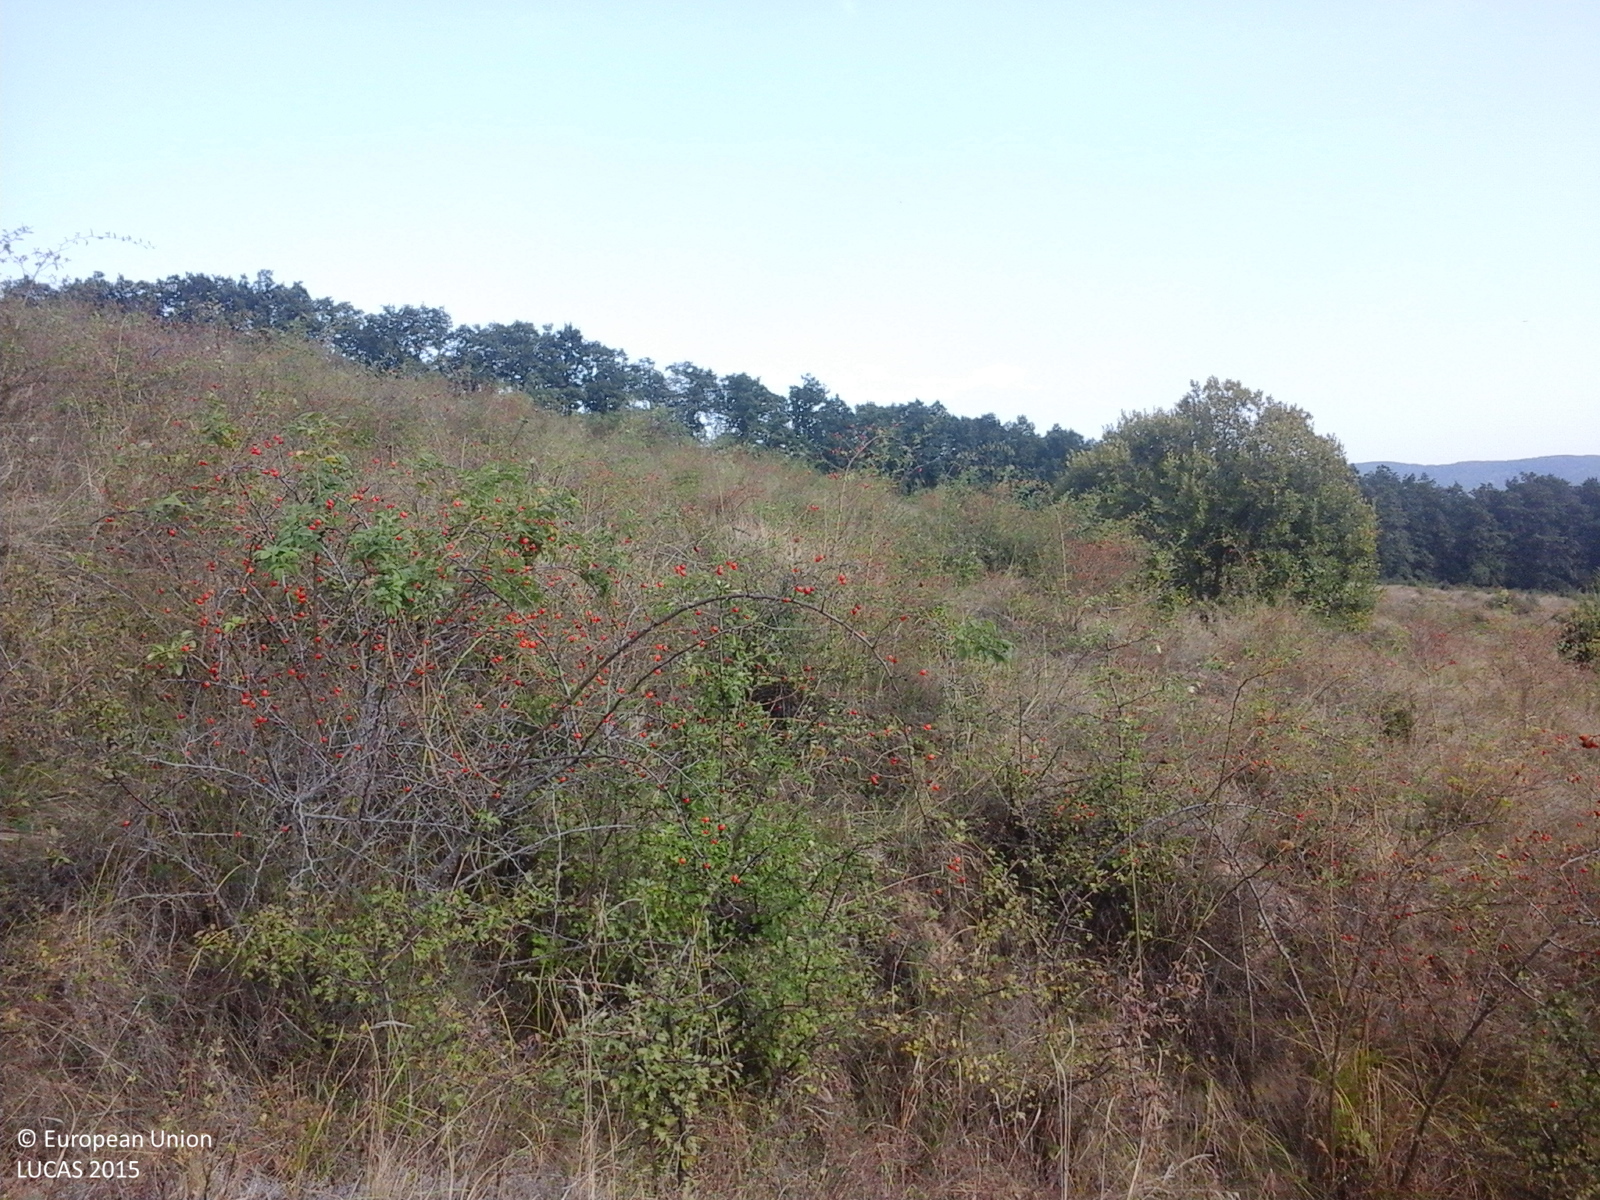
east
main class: Shrubland
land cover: Shrubland without tree cover
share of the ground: > 75 %
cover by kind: shrubs 100 %
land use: Semi-natural and natural areas not in use
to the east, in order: Shrubland without tree cover; Tracks; Shrubland without tree cover; Broadleaved woodland
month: September
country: RO
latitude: 47.2074
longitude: 23.6332
